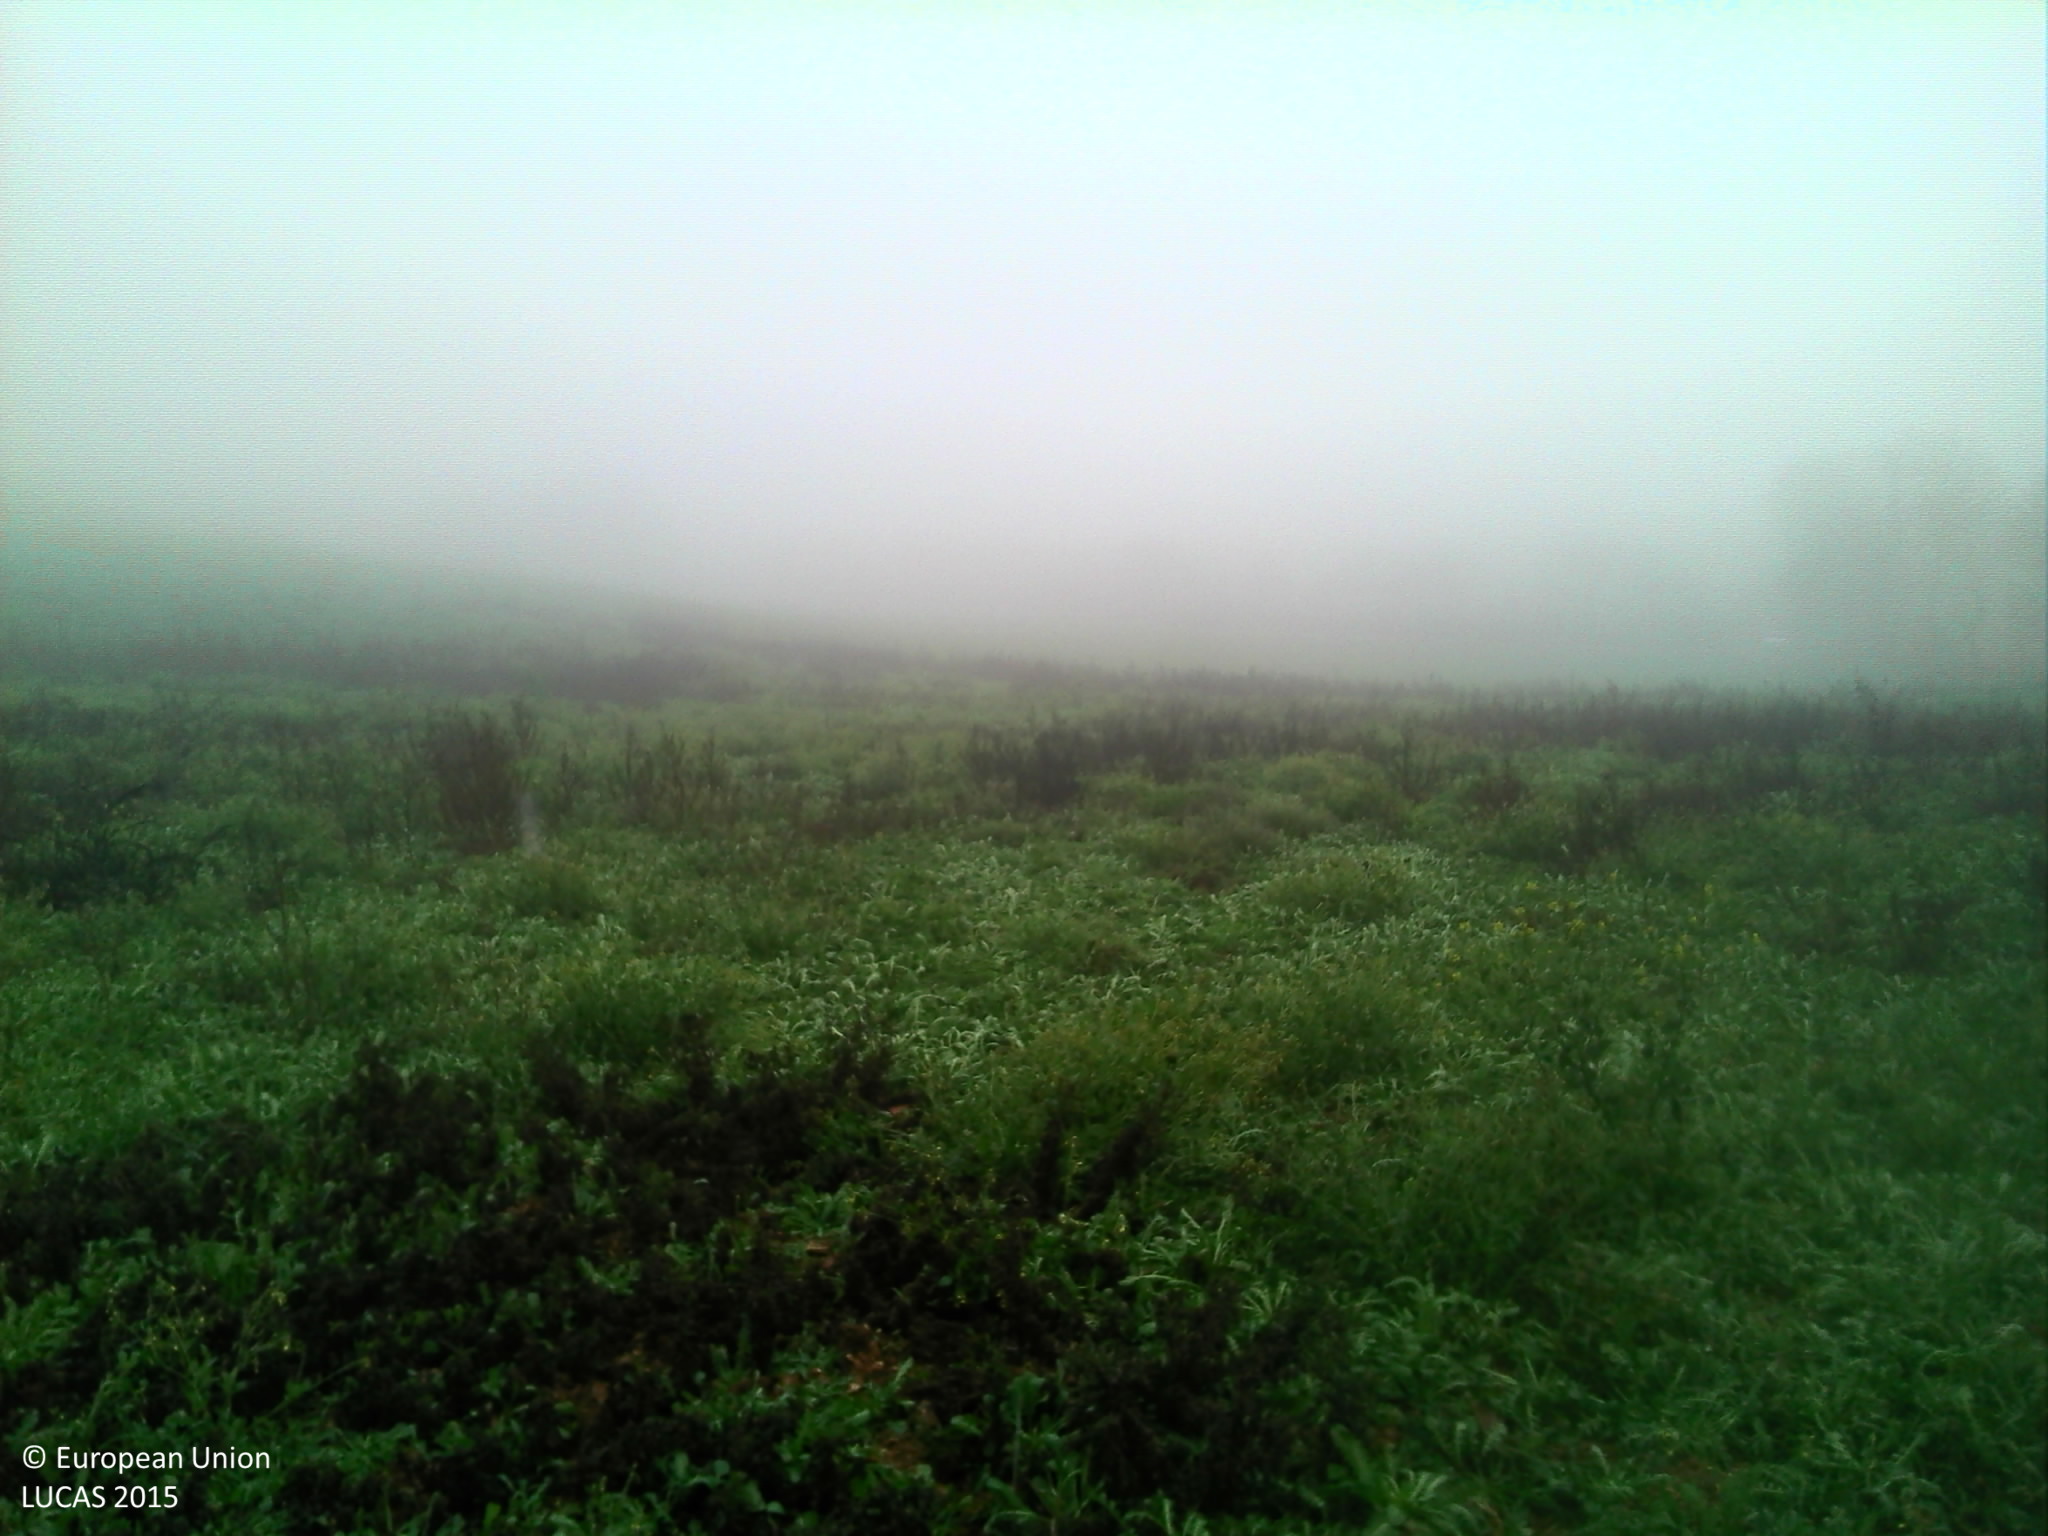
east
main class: Grassland
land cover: Spontaneously vegetated surfaces
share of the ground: > 75 %
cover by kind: herbaceous plants 100 %
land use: Fallow land
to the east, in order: Spontaneously vegetated surfaces; Grassland without tree/shrub cover; Broadleaved woodland; Tracks; Fences; Spontaneously vegetated surfaces; Grassland without tree/shrub cover
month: November
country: FR
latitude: 43.9981
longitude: 3.1602
